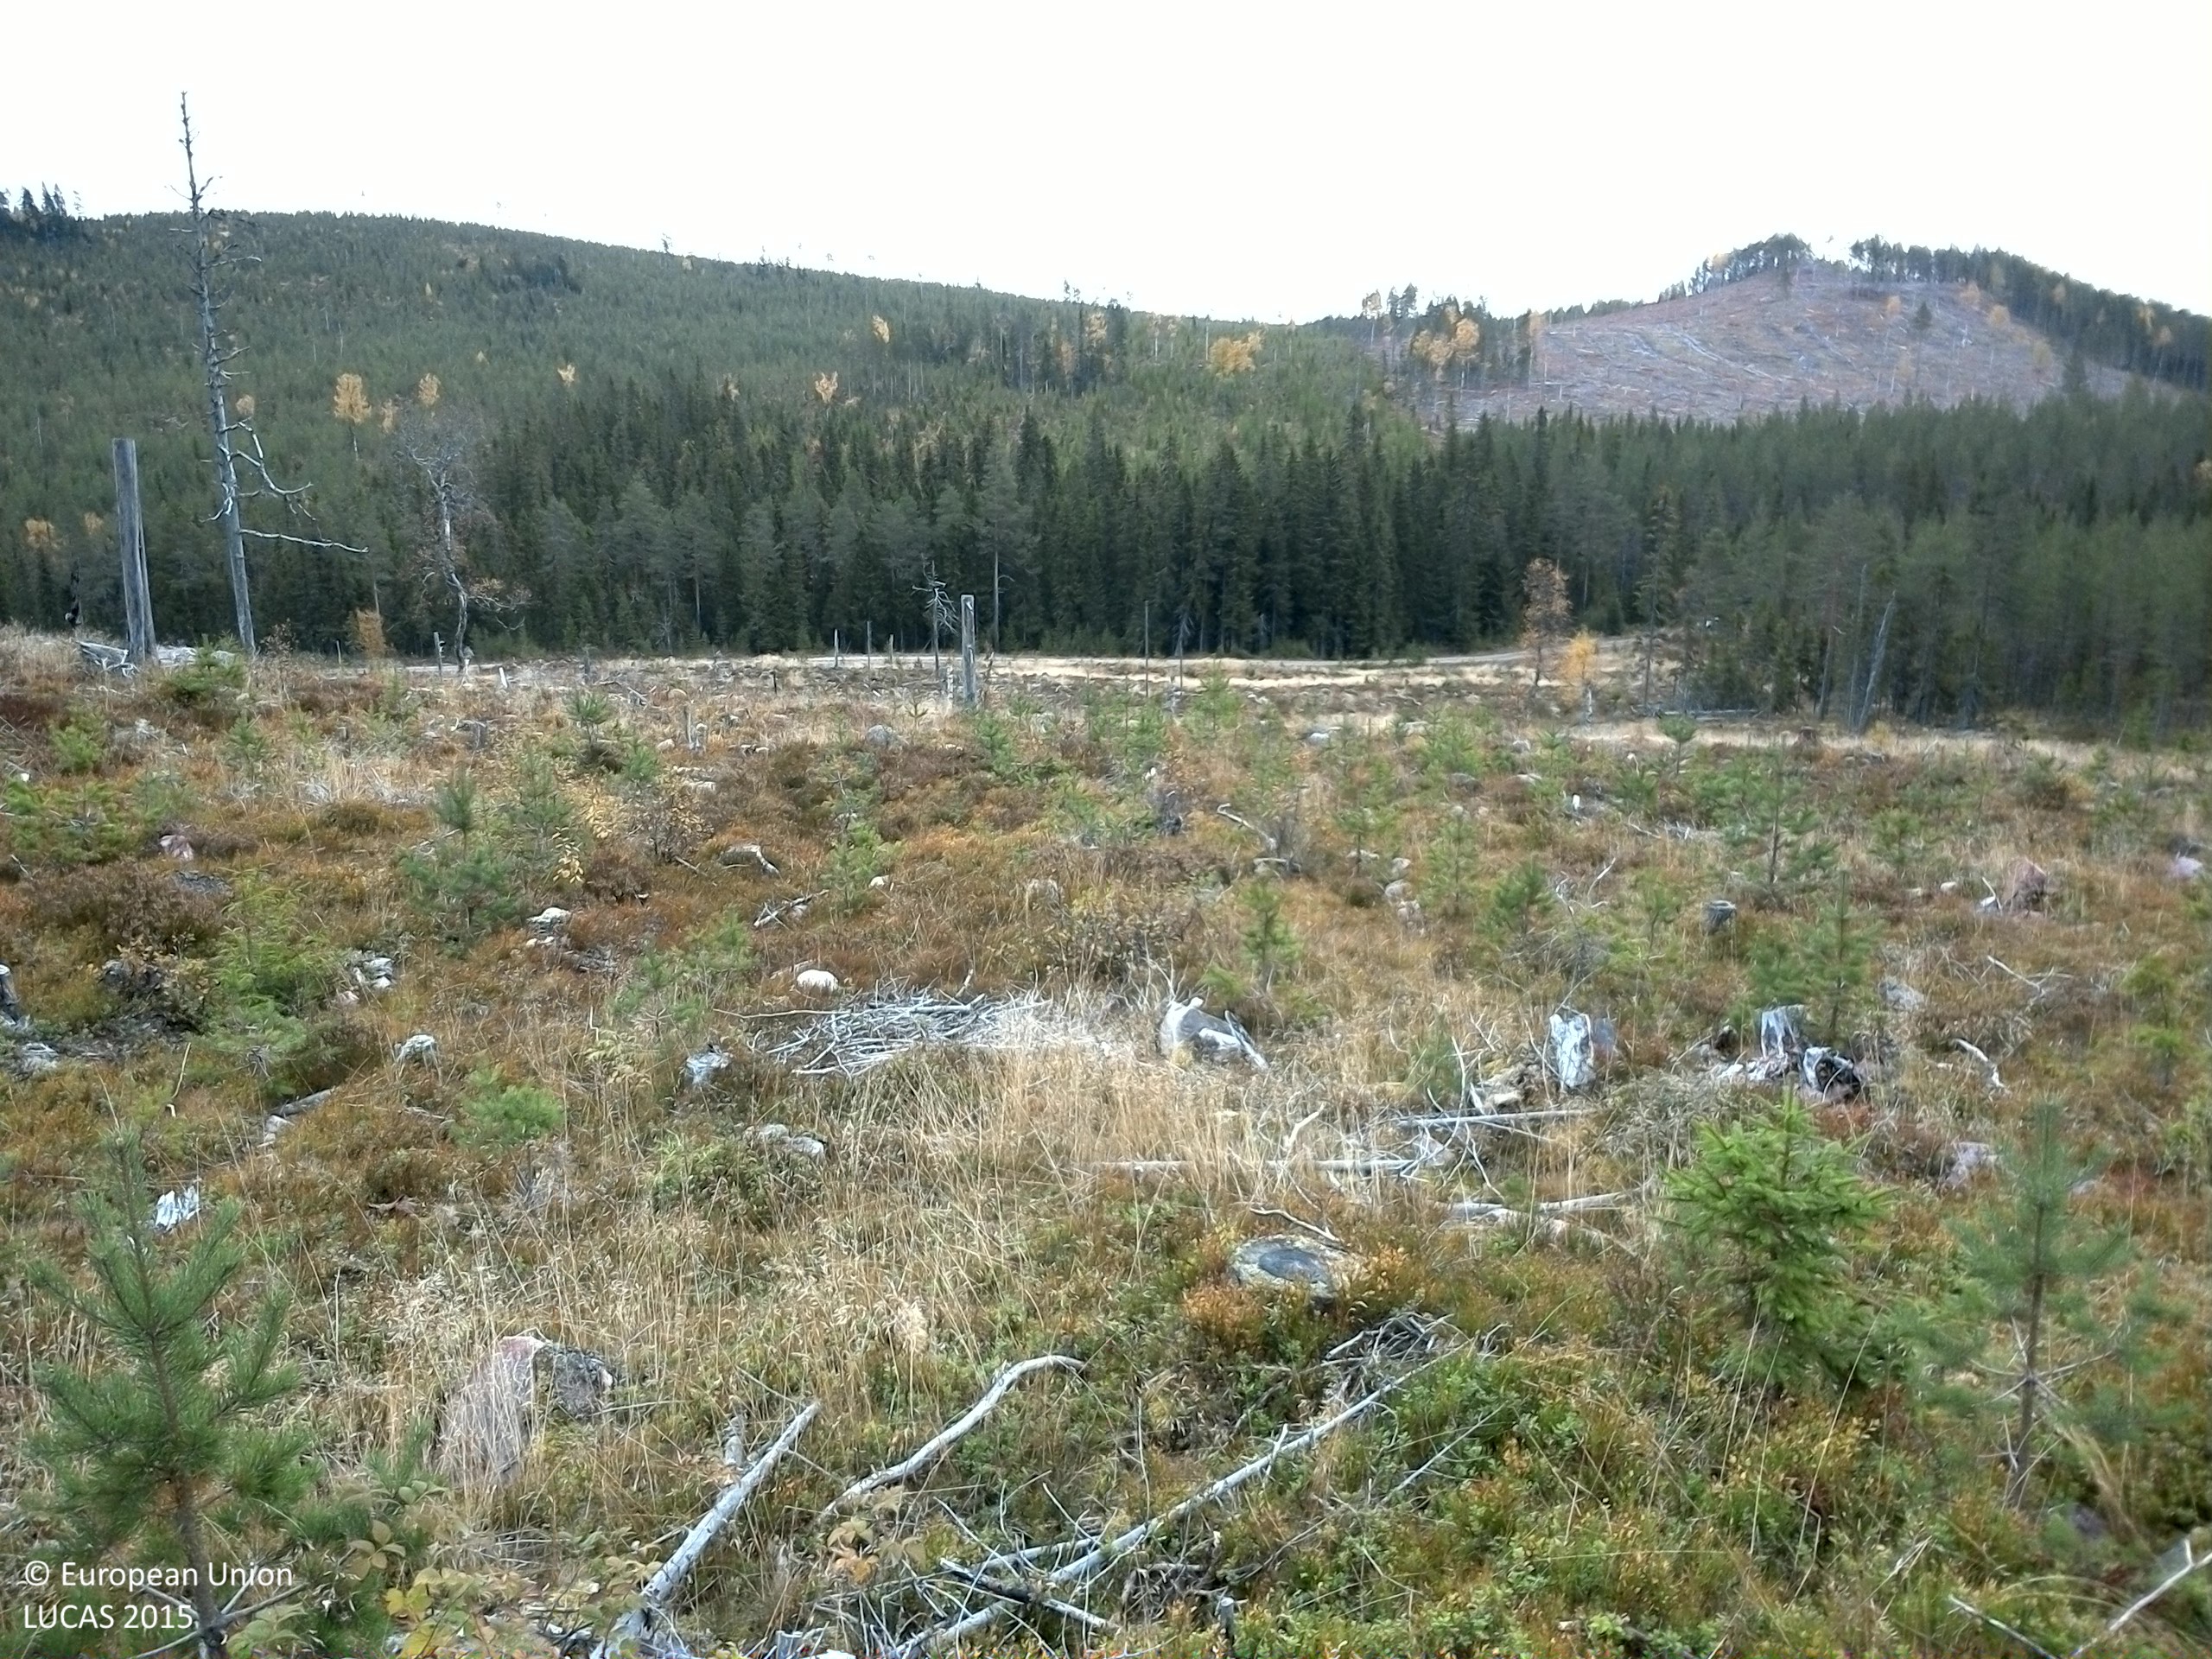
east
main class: Woodland
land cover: Pine dominated coniferous woodland
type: boreal forest
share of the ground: 25 - 50 %
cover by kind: shrubs 55 %, coniferous forest trees 25 %, herbaceous plants 10 %, lichens and mosses 10 %
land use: Forestry
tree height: < 5 m
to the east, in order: Pine dominated coniferous woodland; Paved roads, cycling and walking lanes; Pine dominated mixed woodland; Ditches and canals; Spruce dominated coniferous woodland
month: October
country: SE
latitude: 61.2674
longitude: 14.3683
